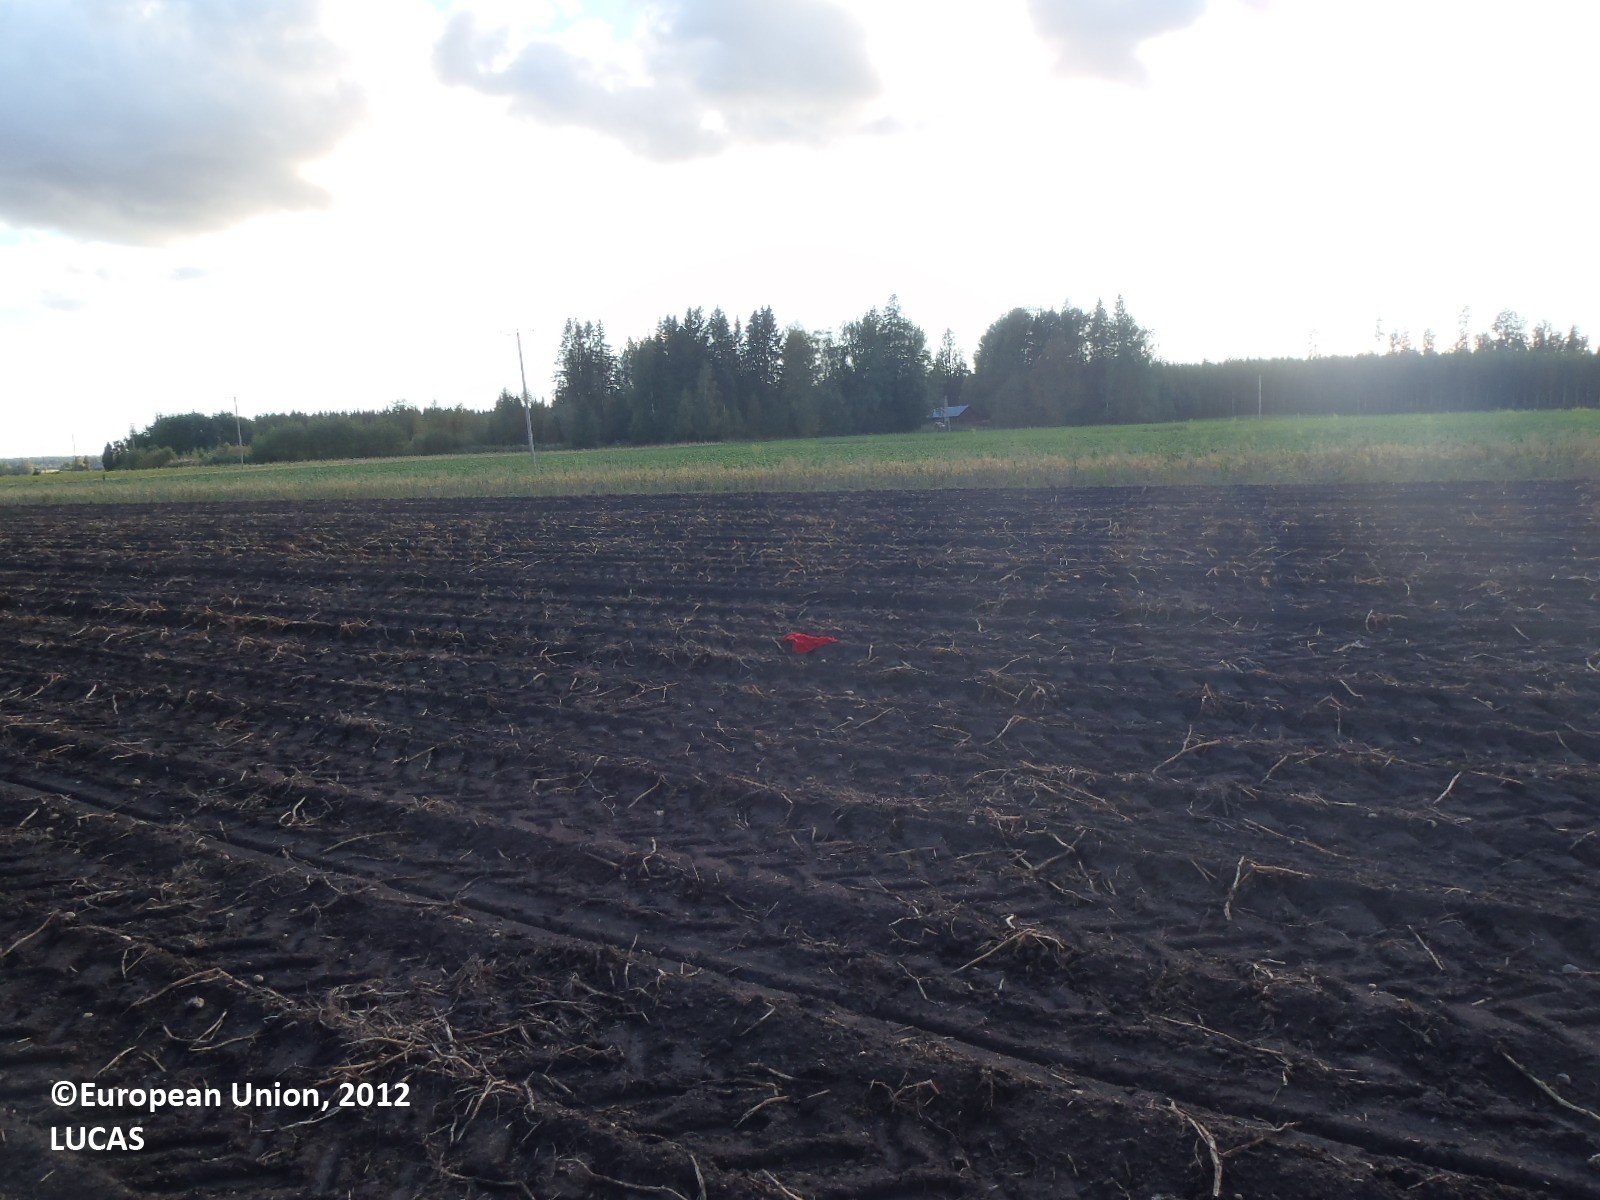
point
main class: Cropland
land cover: Potatoes
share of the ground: > 75 %
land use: Agriculture (excluding fallow land and kitchen gardens)
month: September
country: FI
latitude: 61.0796
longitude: 22.5426
